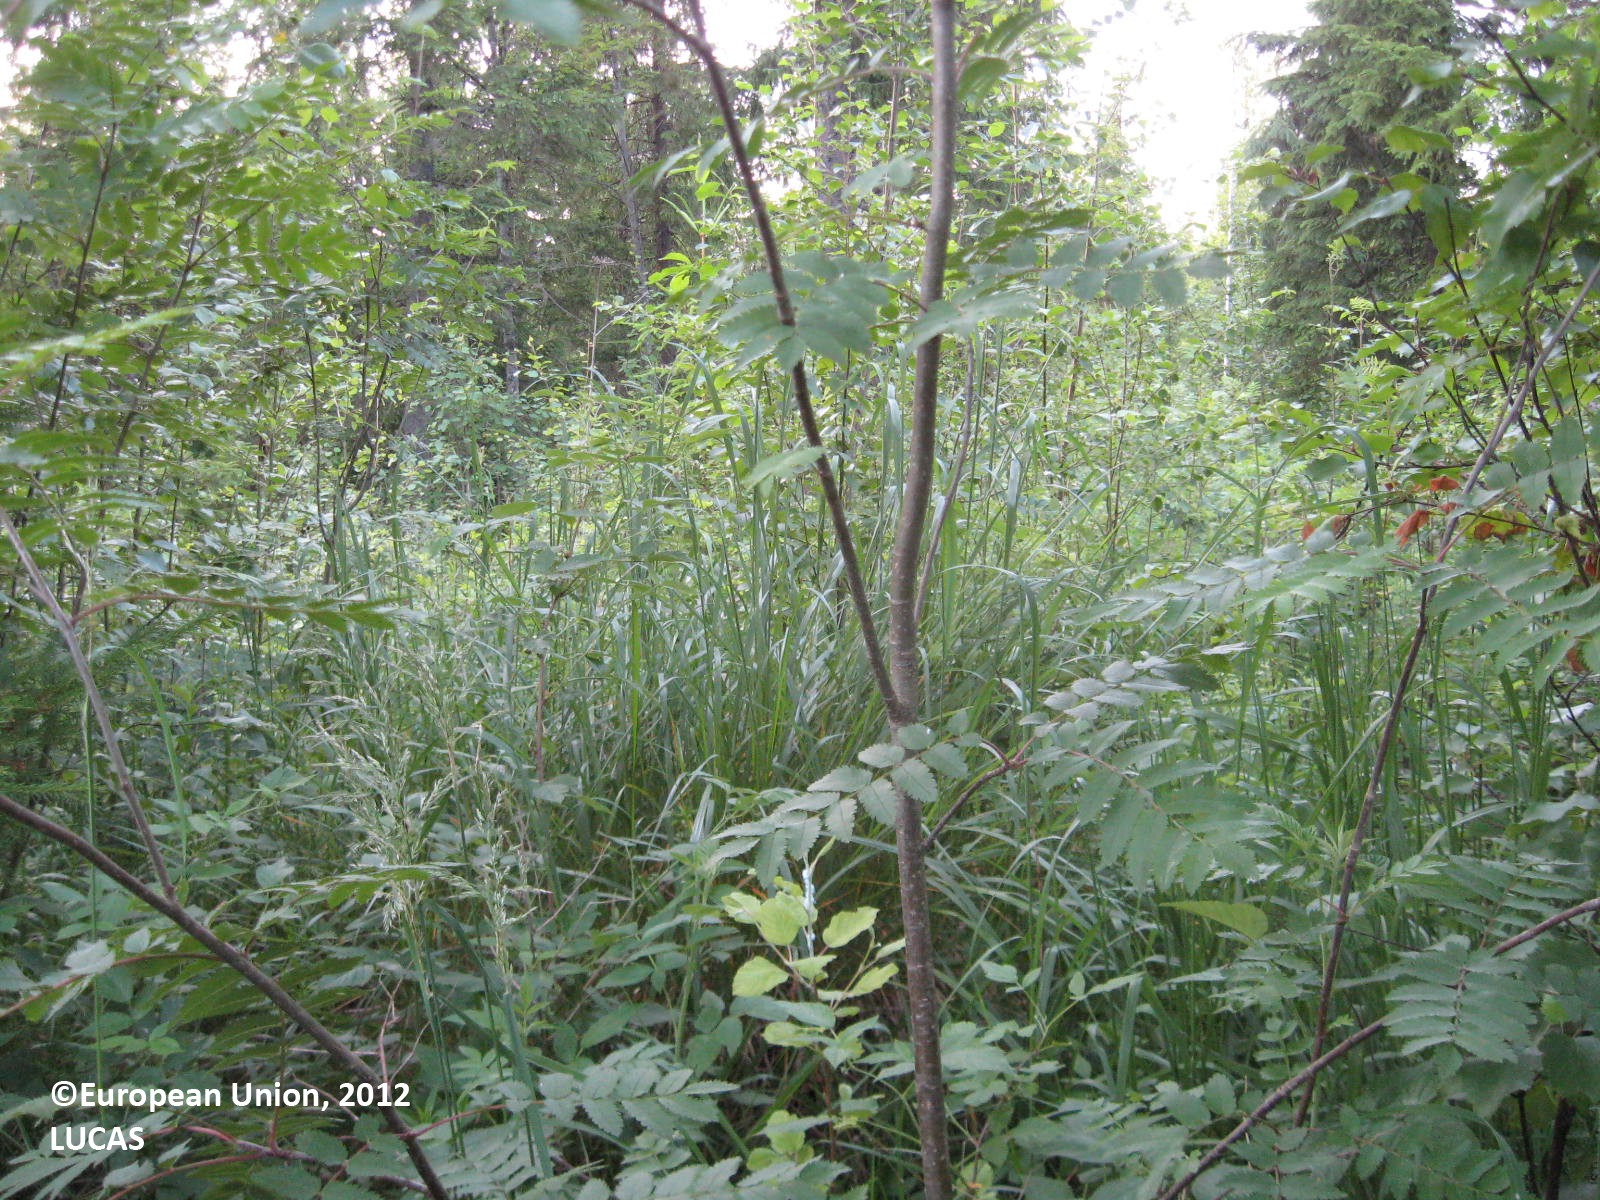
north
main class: Woodland
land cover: Broadleaved woodland
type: boreal forest
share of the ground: > 75 %
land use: Forestry
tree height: > 5 m
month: July
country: FI
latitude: 62.4888
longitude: 21.6298
